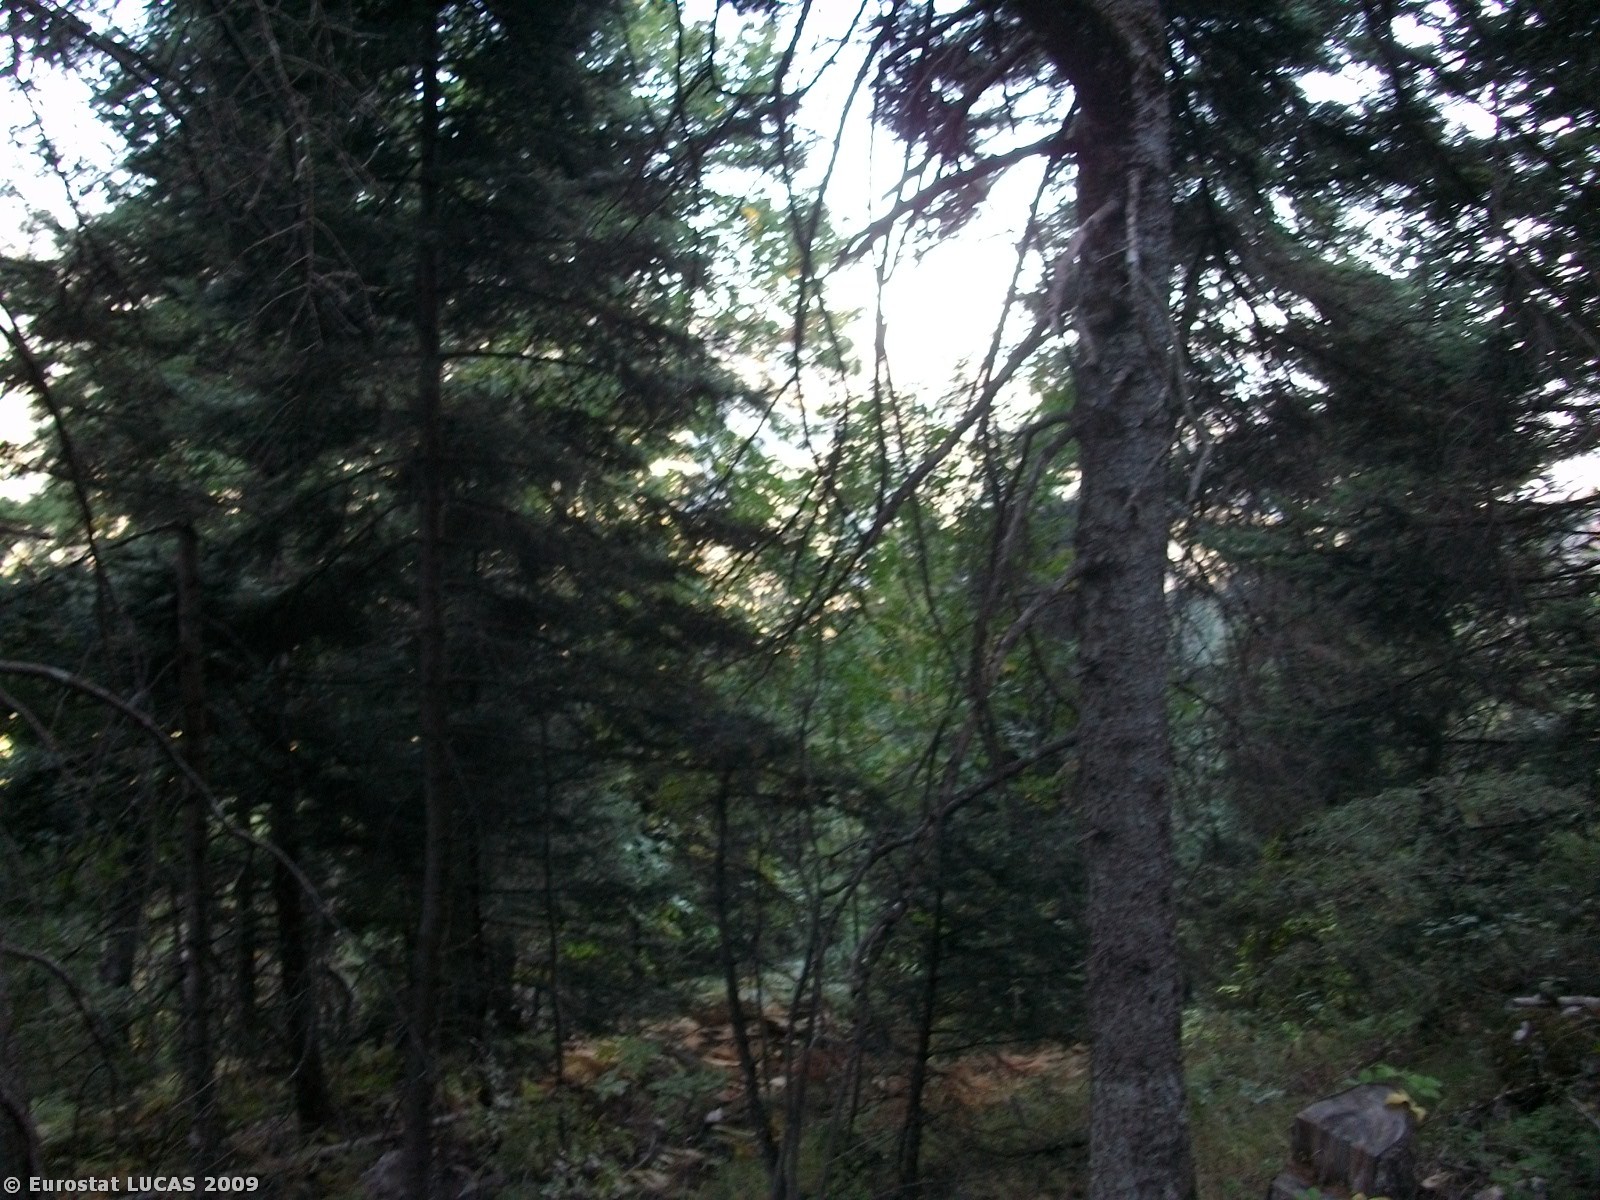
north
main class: Woodland
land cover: Coniferous woodland
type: coniferous forest of the mediterranean region
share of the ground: > 75 %
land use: Forestry
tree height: > 5 m
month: October
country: GR
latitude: 38.7317
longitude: 22.3671
